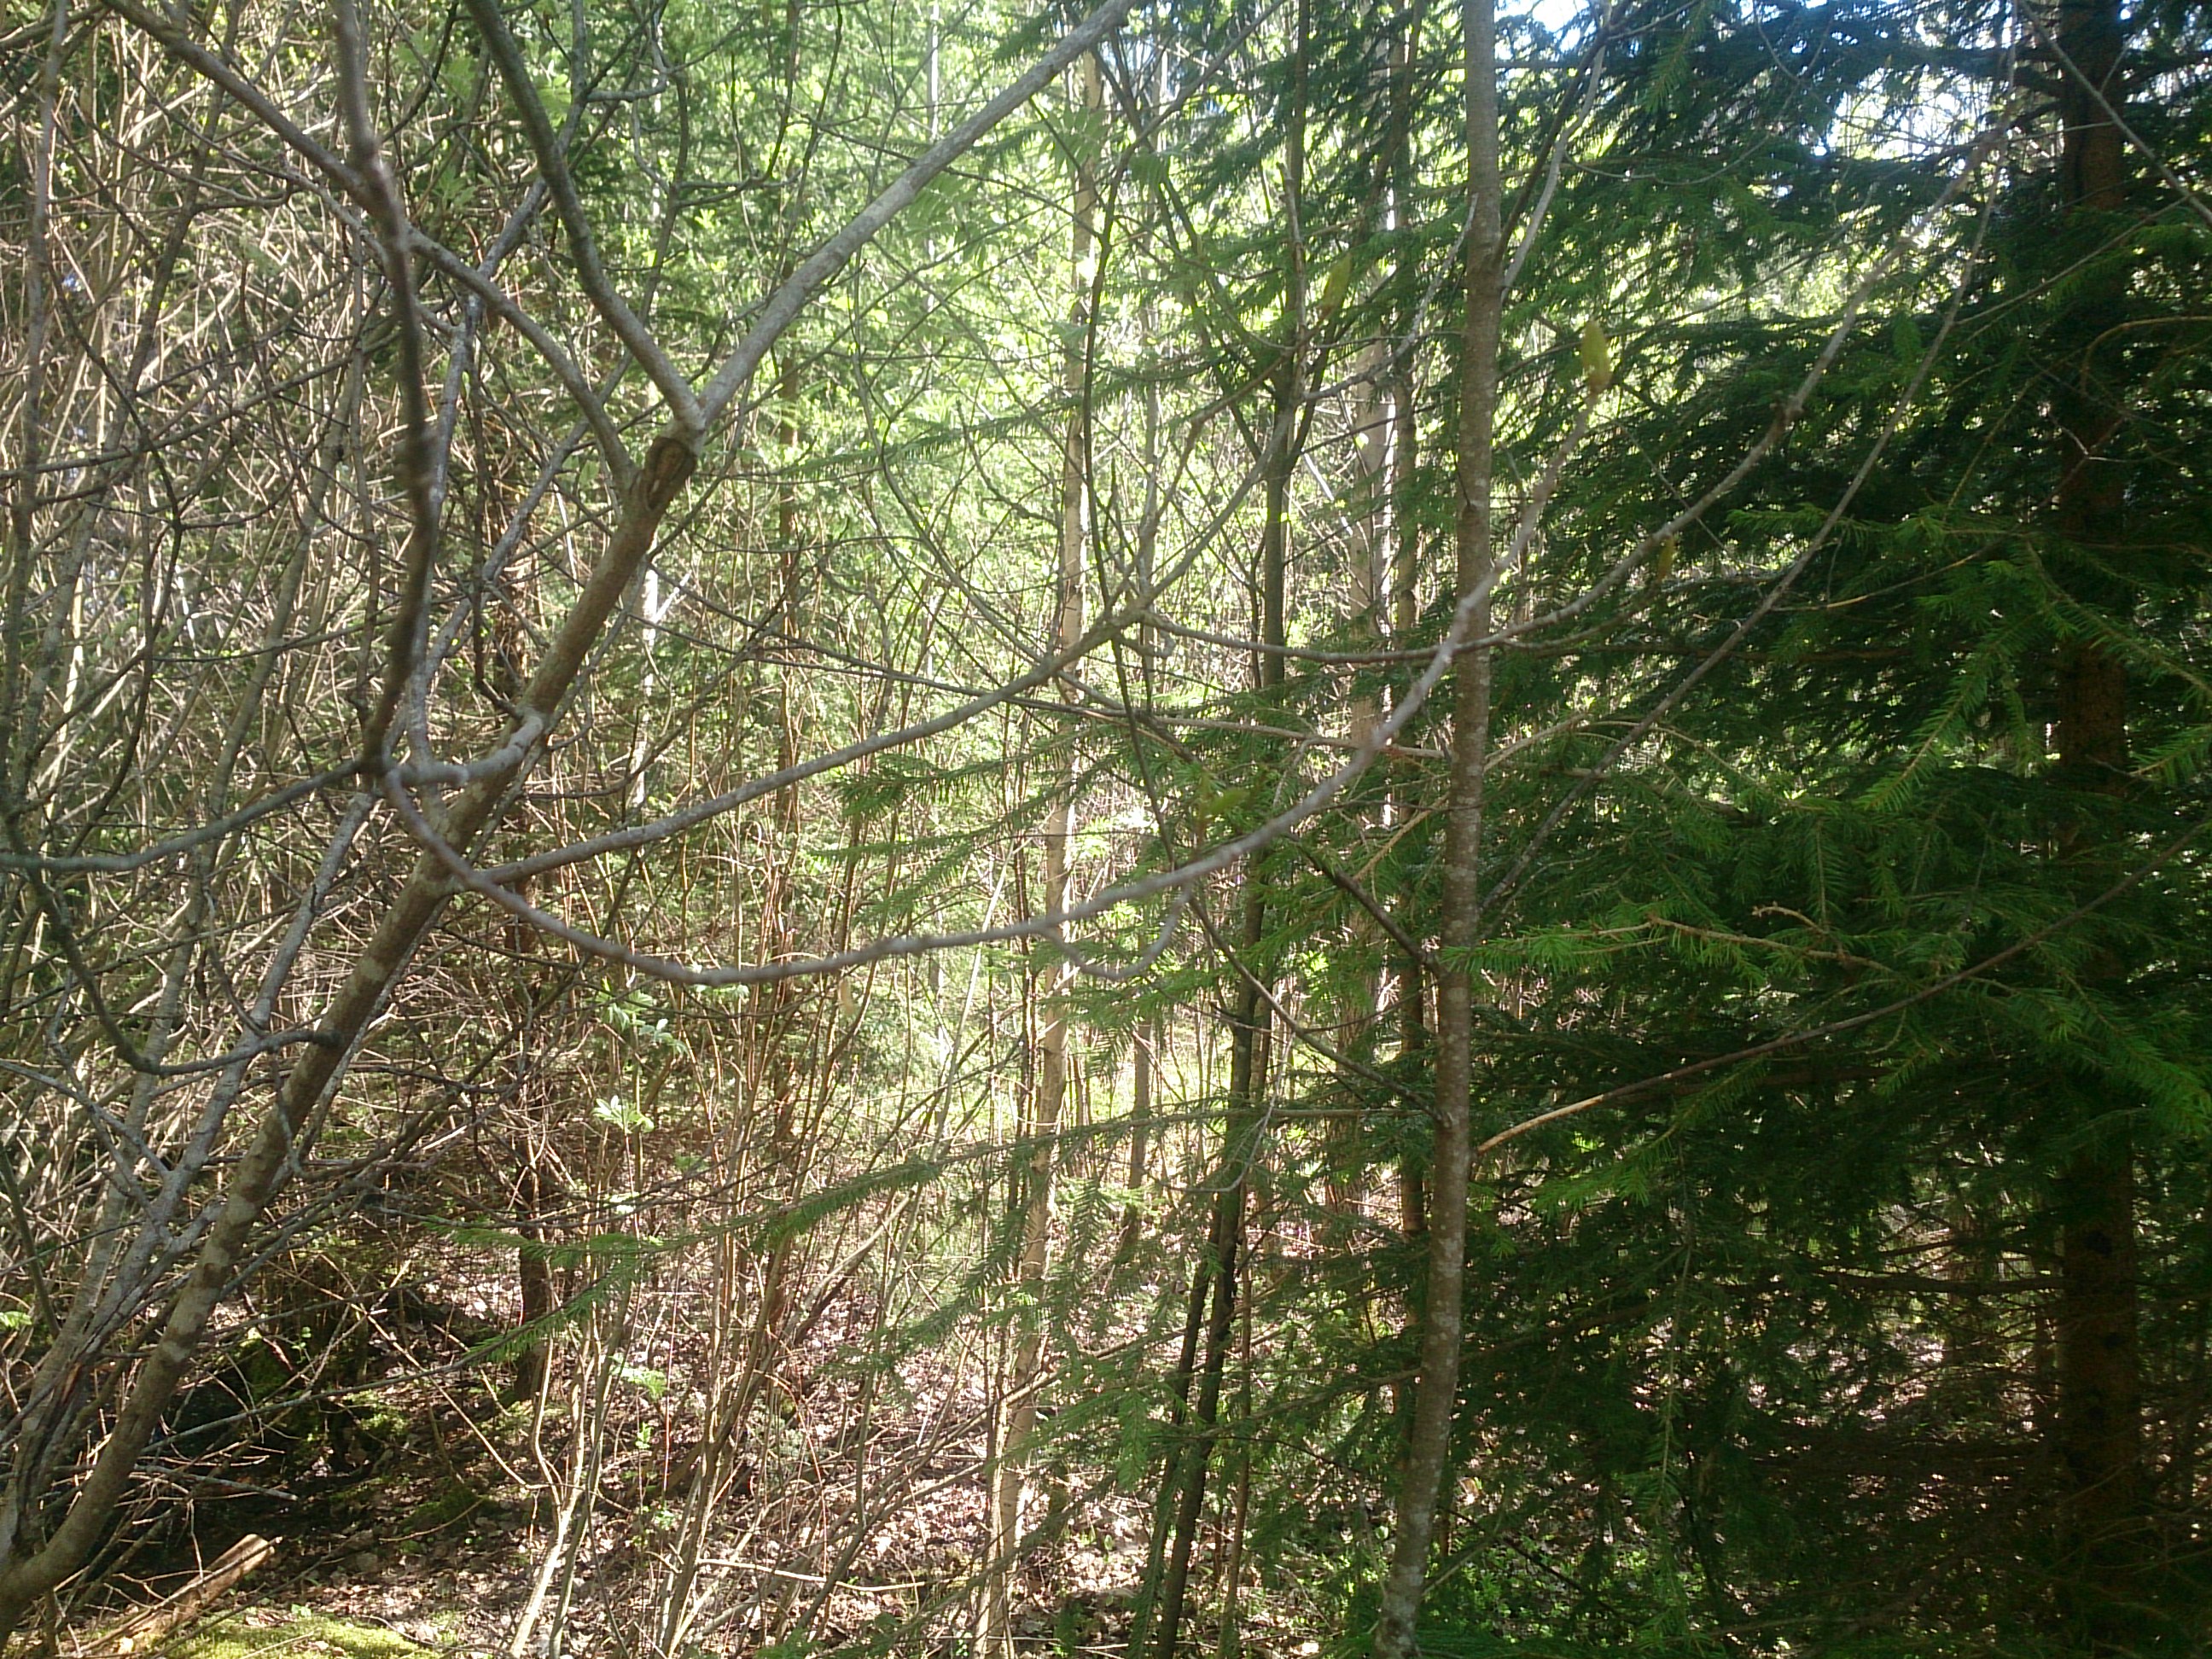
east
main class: Woodland
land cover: Spruce dominated mixed woodland
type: hemiboreal forest and nemoral coniferous forest and mixed broadleaved-coniferous forest
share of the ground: > 75 %
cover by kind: coniferous forest trees 40 %, broadleaved forest trees 40 %, herbaceous plants 10 %, lichens and mosses 10 %
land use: Forestry
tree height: > 5 m
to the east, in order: Spruce dominated mixed woodland; Electric lines; Broadleaved woodland; Grassland without tree/shrub cover
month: May
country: LV
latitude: 56.7144
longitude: 24.3212
